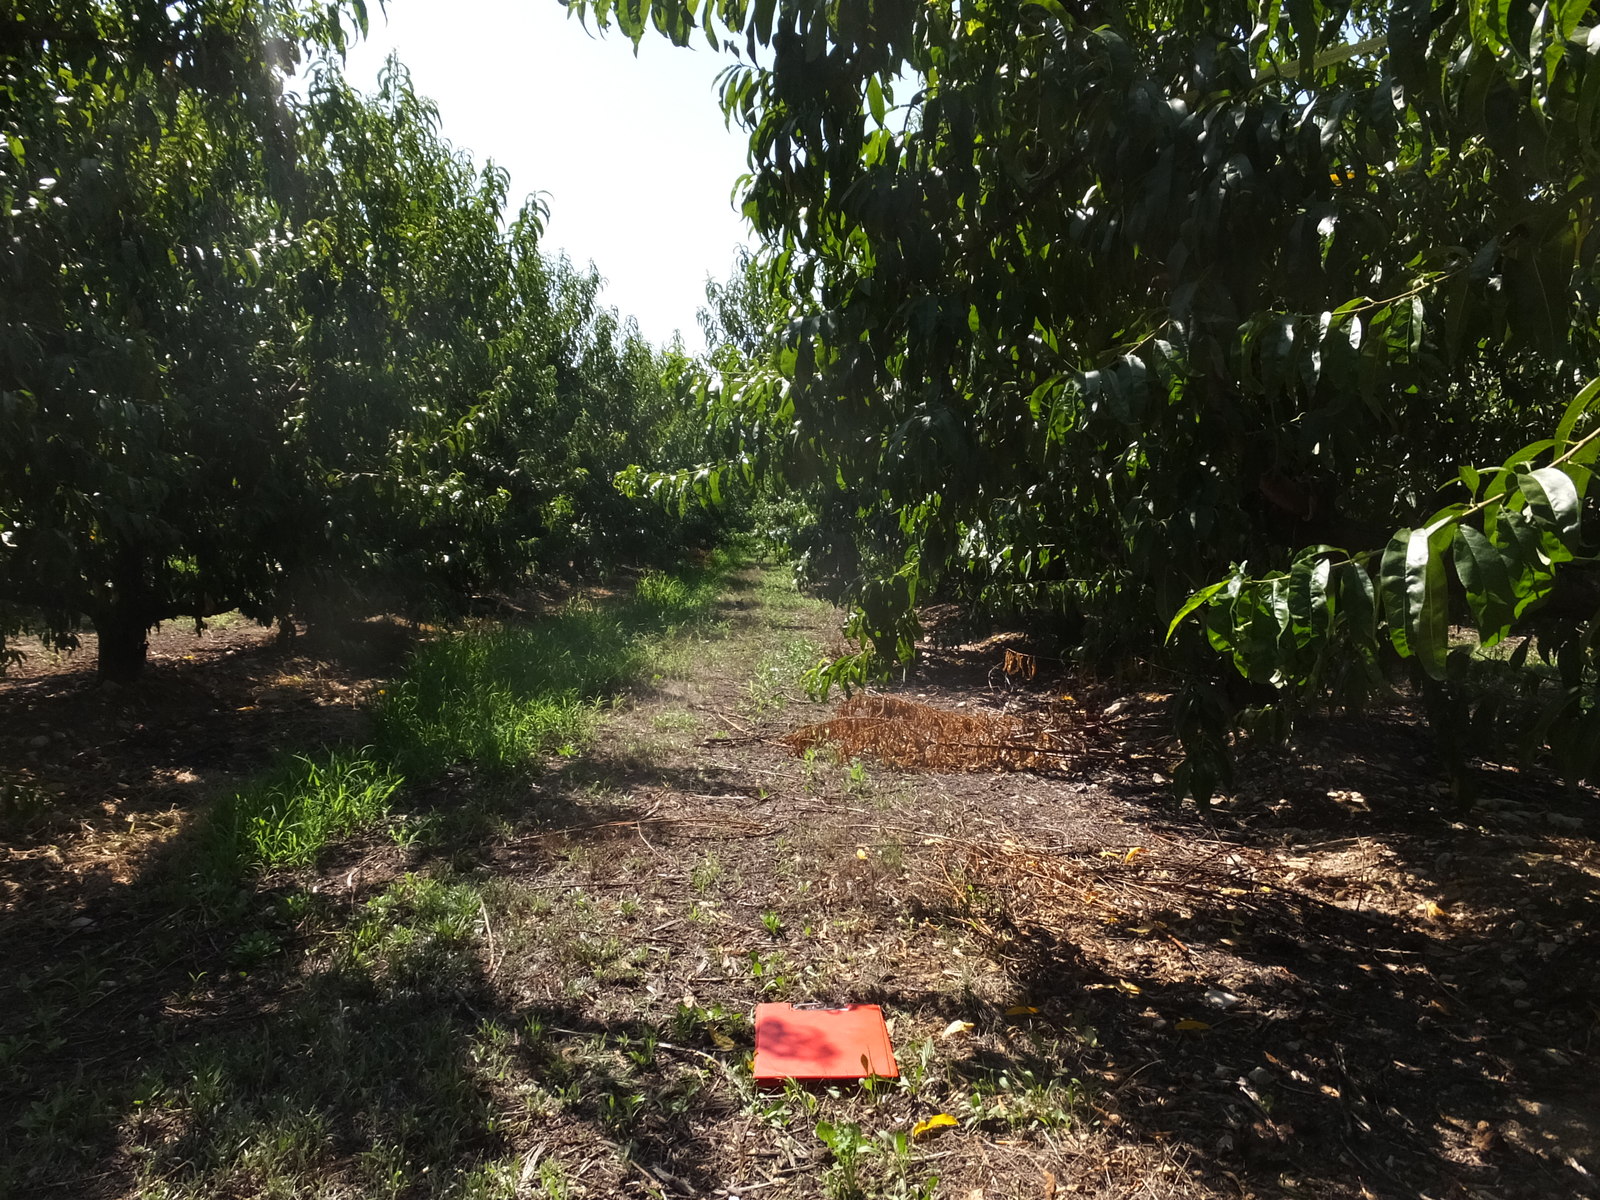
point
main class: Cropland
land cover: Other fruit trees and berries
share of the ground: > 75 %
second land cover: Spontaneously vegetated surfaces
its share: < 10 %
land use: Agriculture (excluding fallow land and kitchen gardens)
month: August
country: ES
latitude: 41.4774
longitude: 0.1066
